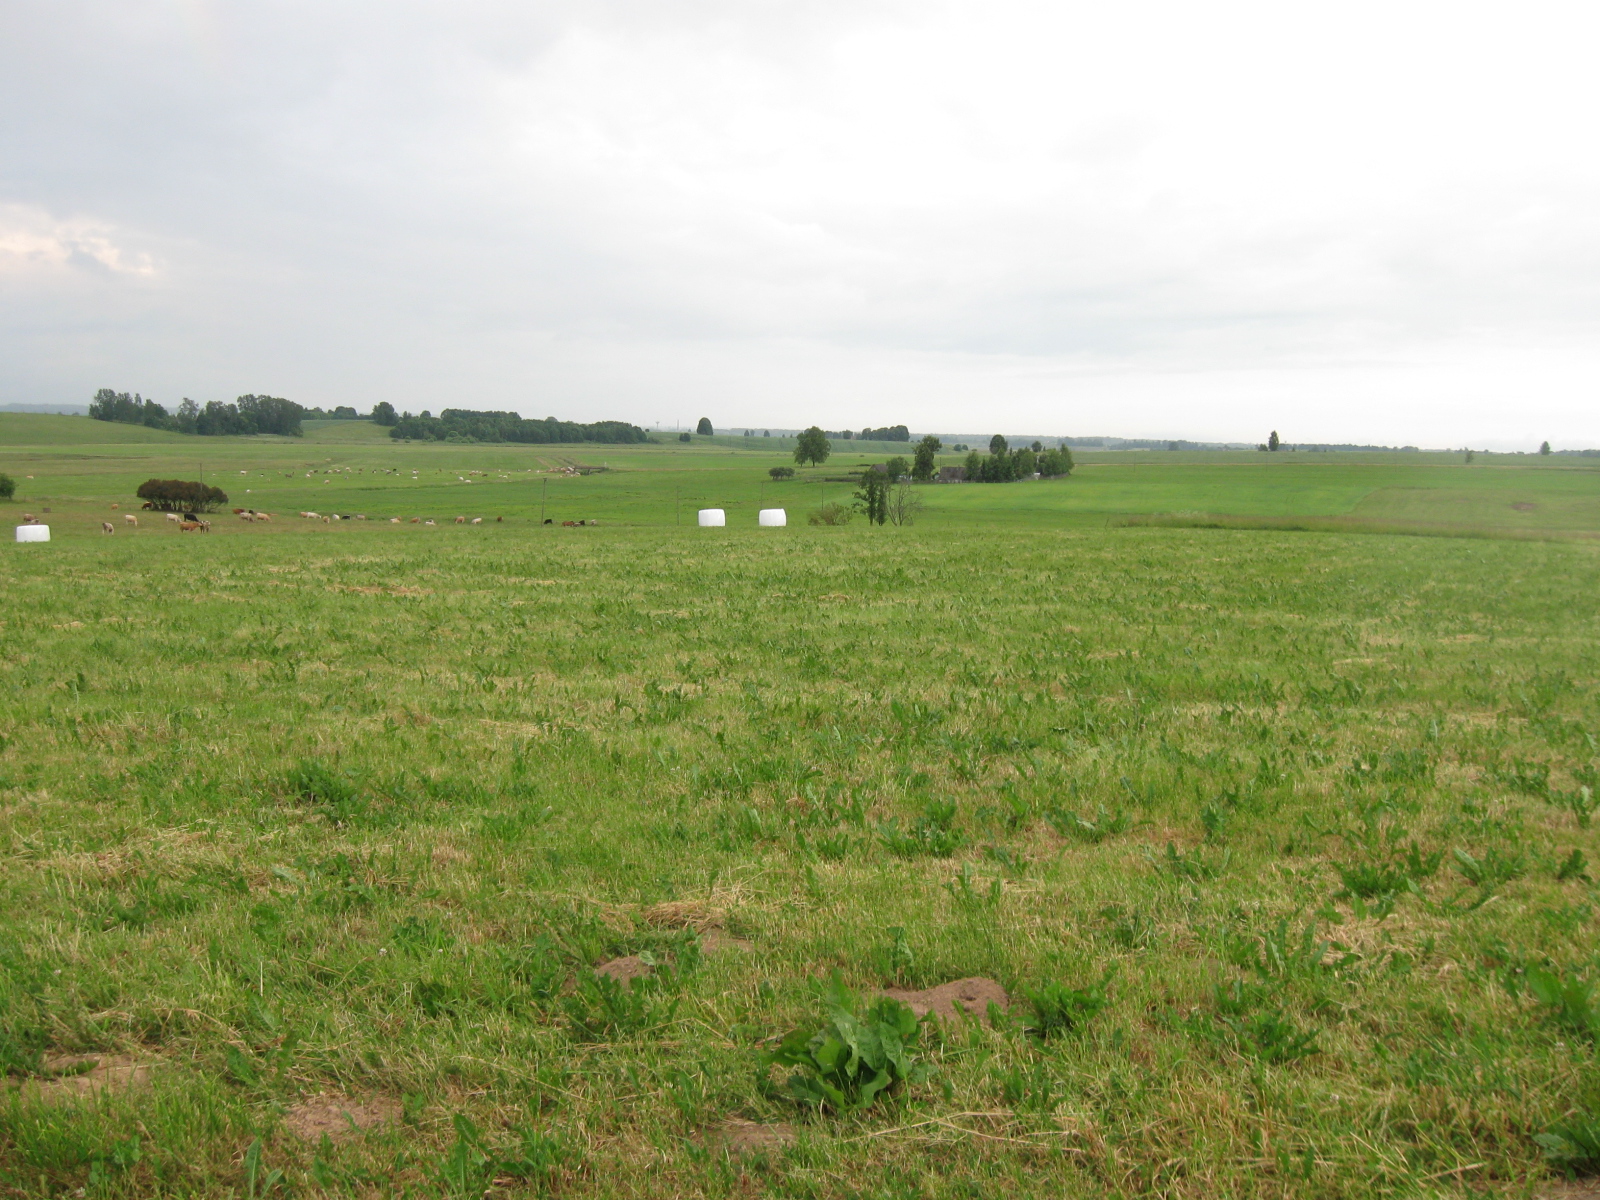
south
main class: Grassland
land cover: Grassland without tree/shrub cover
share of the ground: > 75 %
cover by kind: herbaceous plants 90 %, unconsolidated bare surface 10 %
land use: Agriculture (excluding fallow land and kitchen gardens)
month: June
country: LT
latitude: 54.9257
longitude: 24.4408
